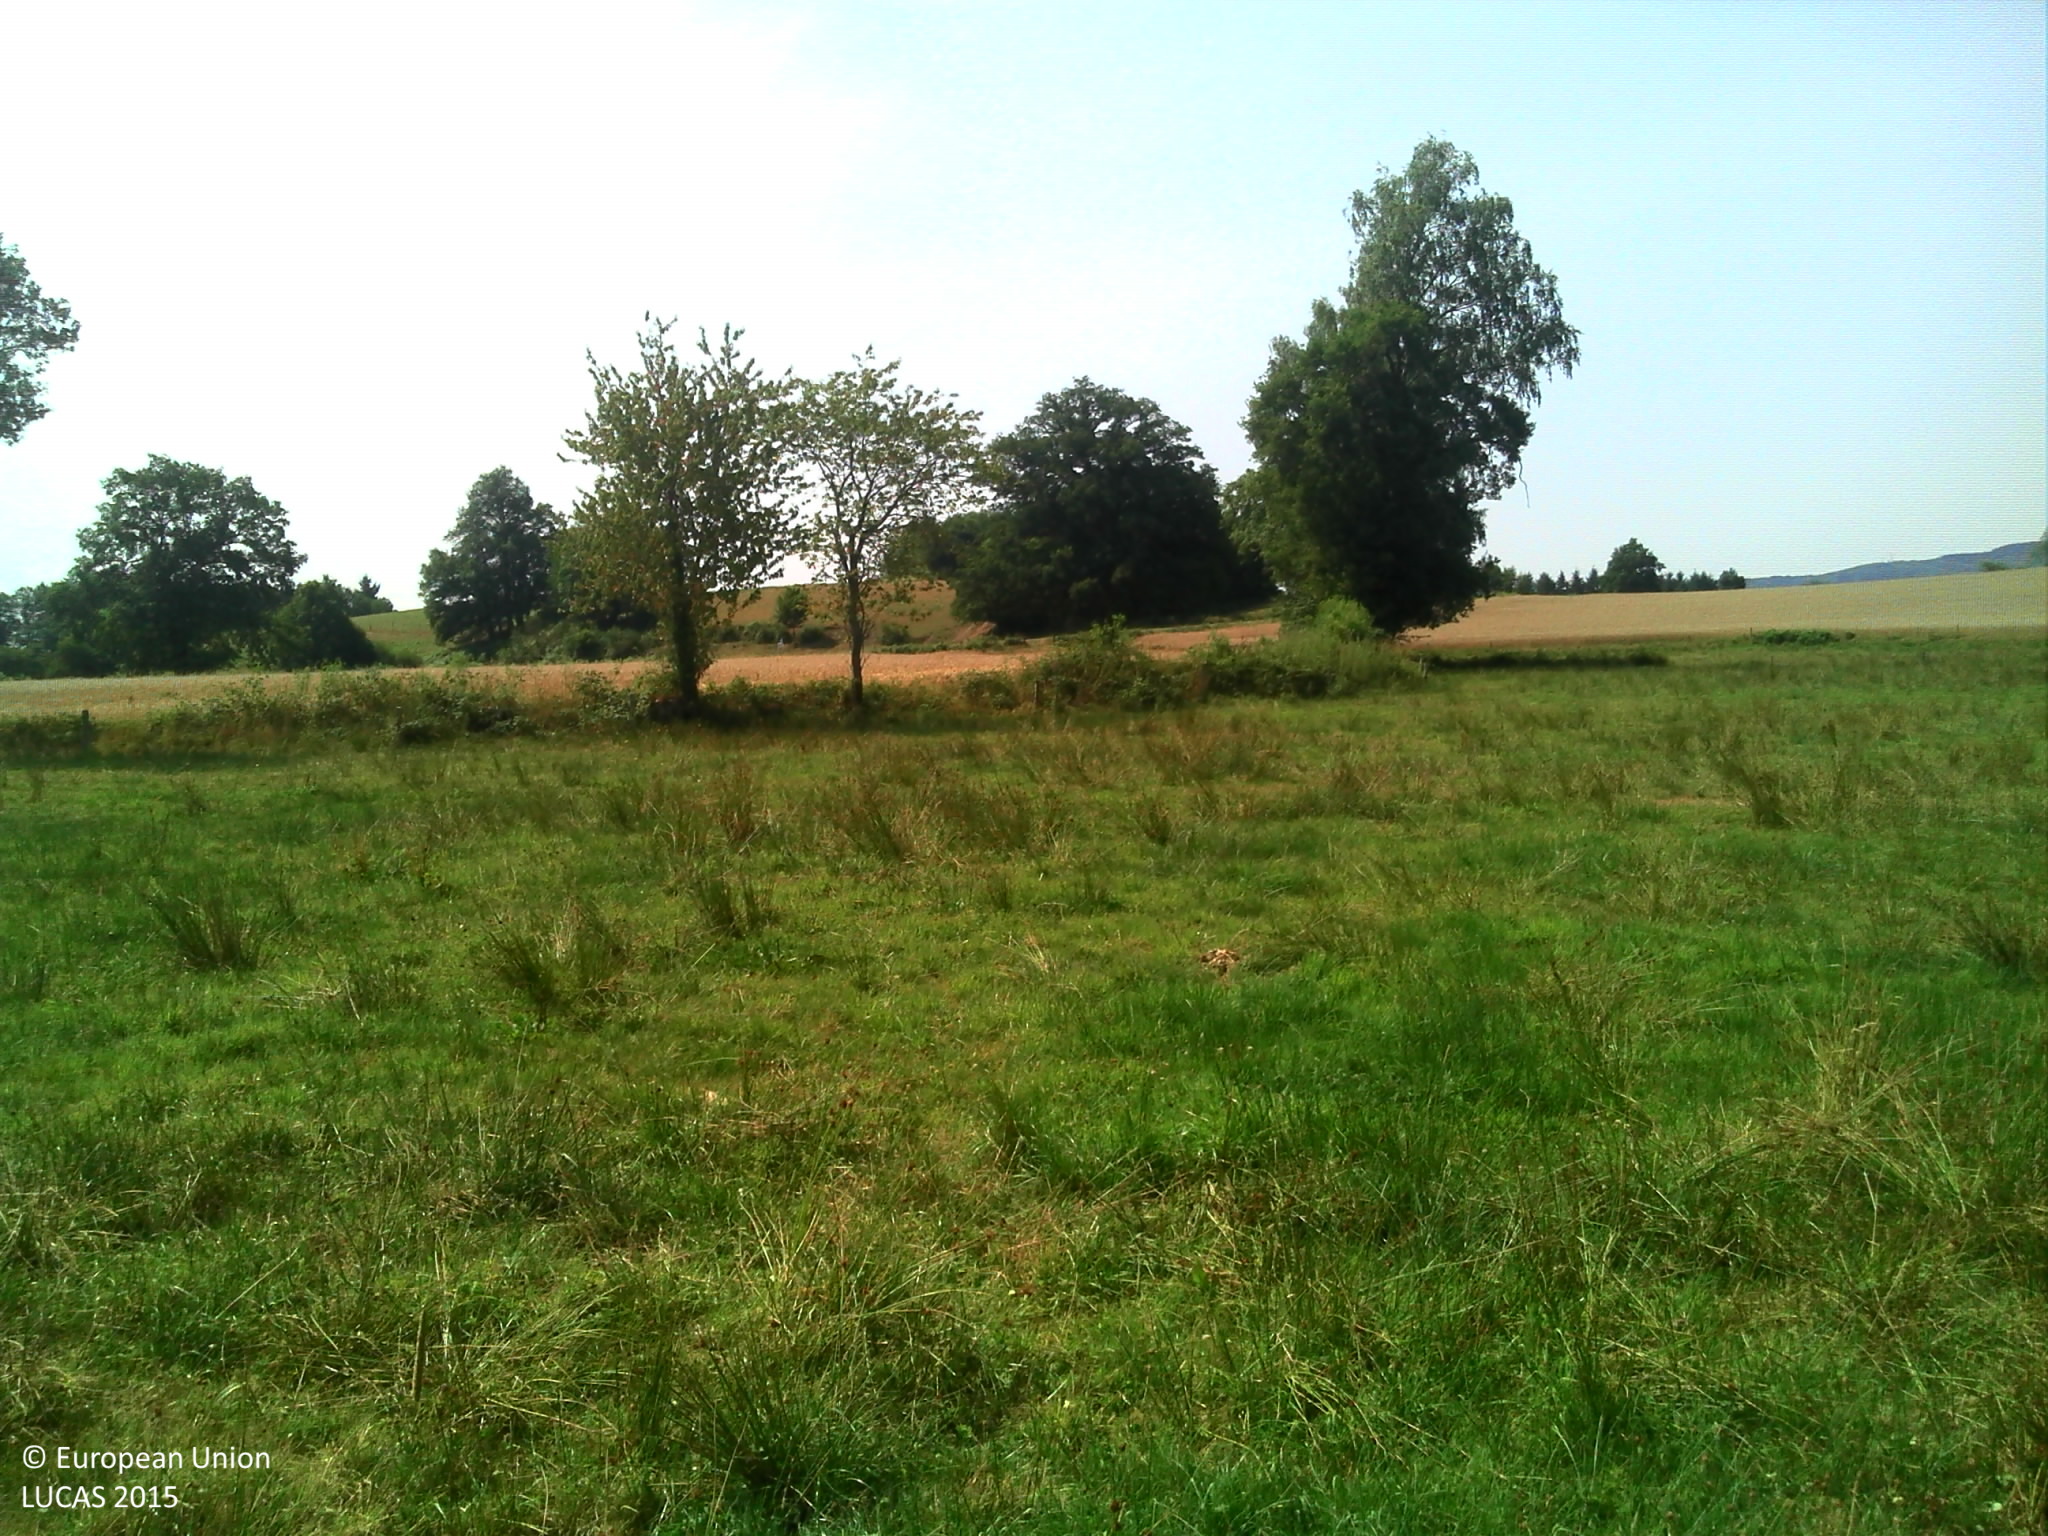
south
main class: Grassland
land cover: Grassland without tree/shrub cover
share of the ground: > 75 %
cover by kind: herbaceous plants 95 %, shrubs 5 %
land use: Agriculture (excluding fallow land and kitchen gardens)
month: July
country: FR
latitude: 46.0470
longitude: 1.7087
